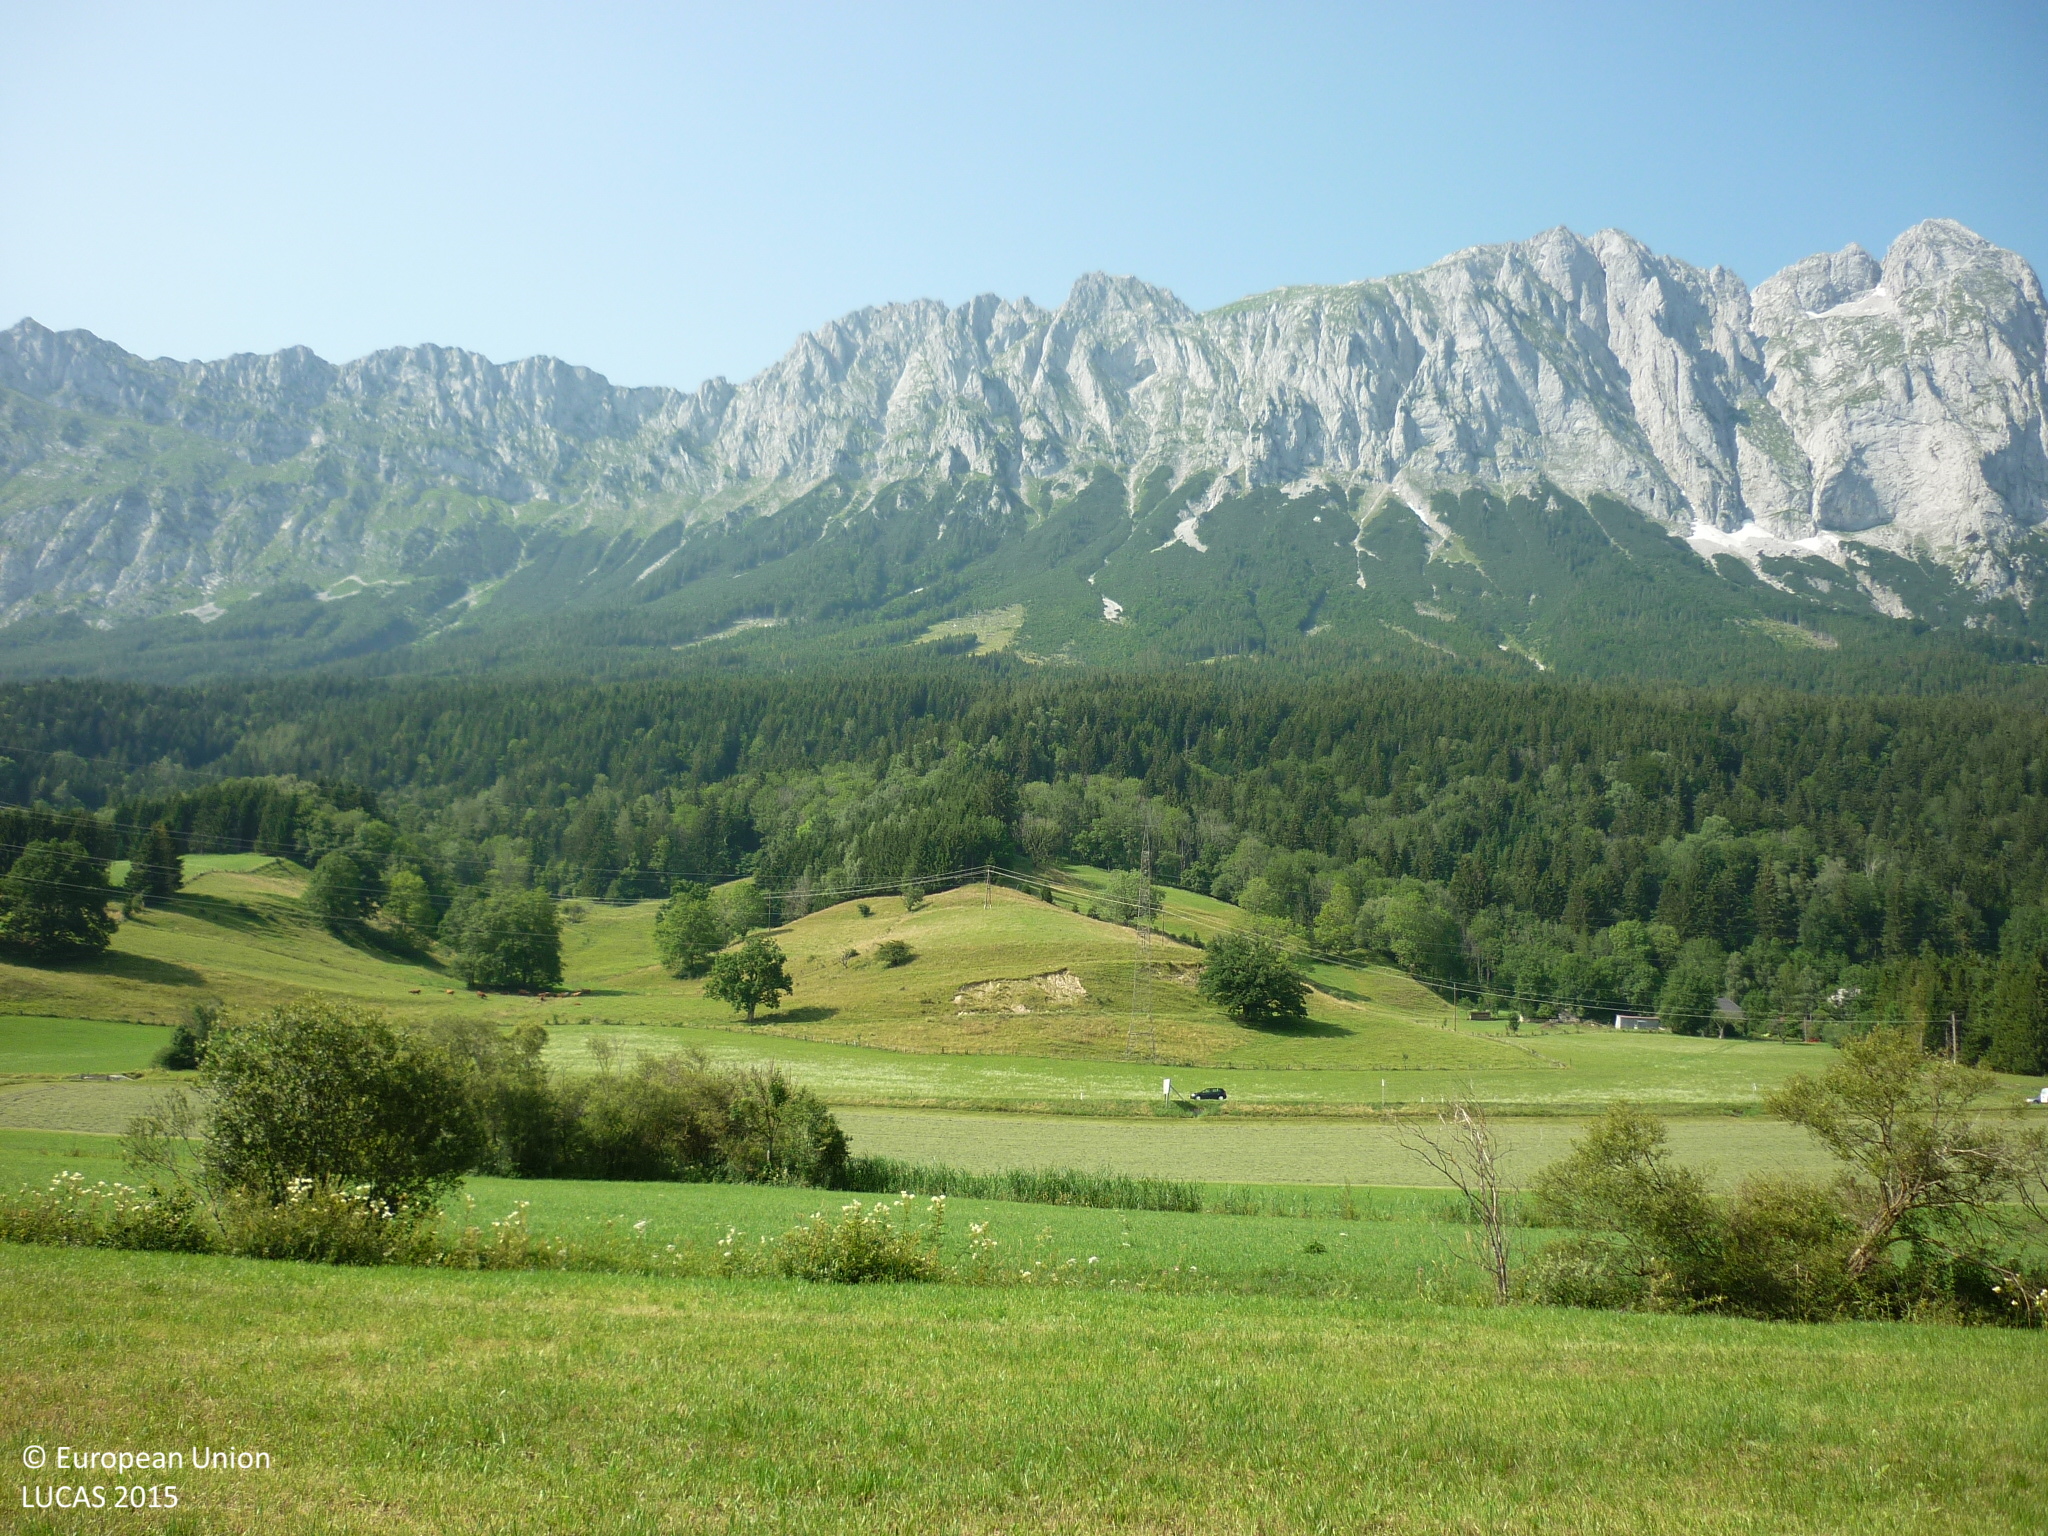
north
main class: Grassland
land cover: Grassland without tree/shrub cover
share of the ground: > 75 %
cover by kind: herbaceous plants 100 %
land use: Agriculture (excluding fallow land and kitchen gardens)
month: July
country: AT
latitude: 47.4845
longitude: 13.9933
